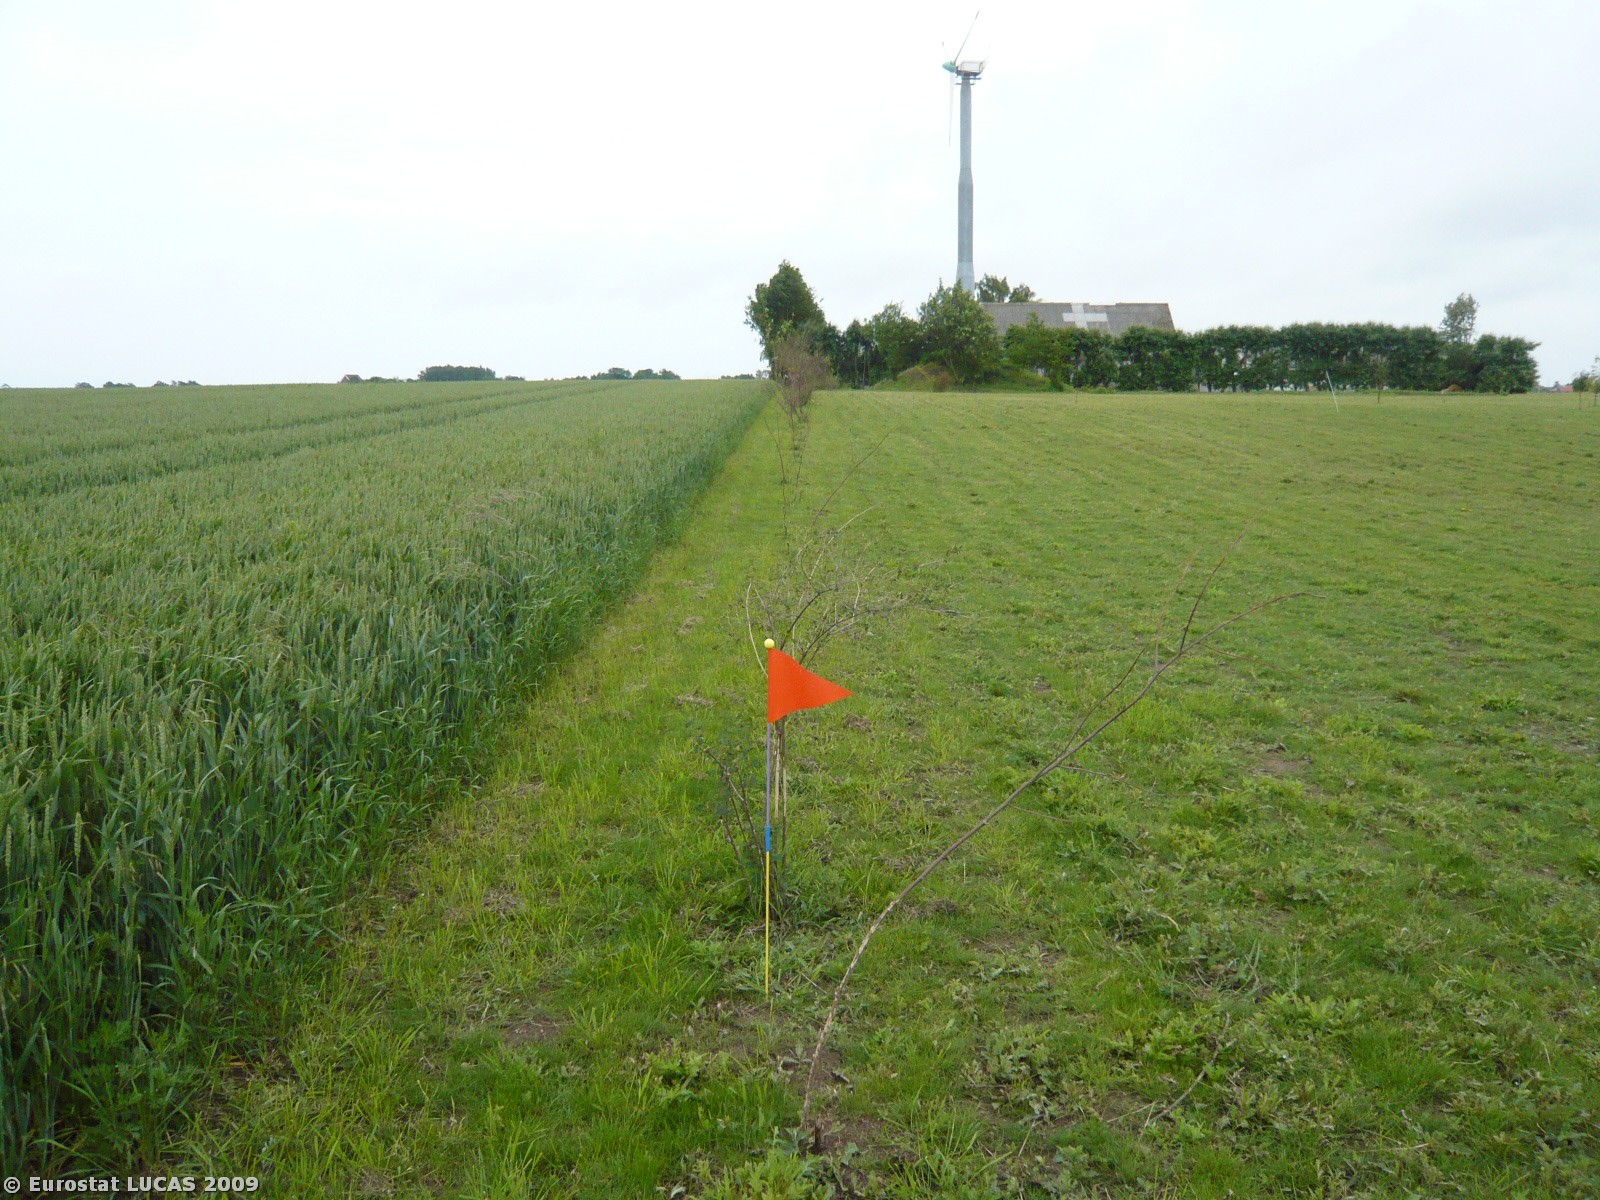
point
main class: Grassland
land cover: Grassland with sparse tree/shrub cover
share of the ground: > 75 %
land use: Residential
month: June
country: DK
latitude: 54.7522
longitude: 11.9720
